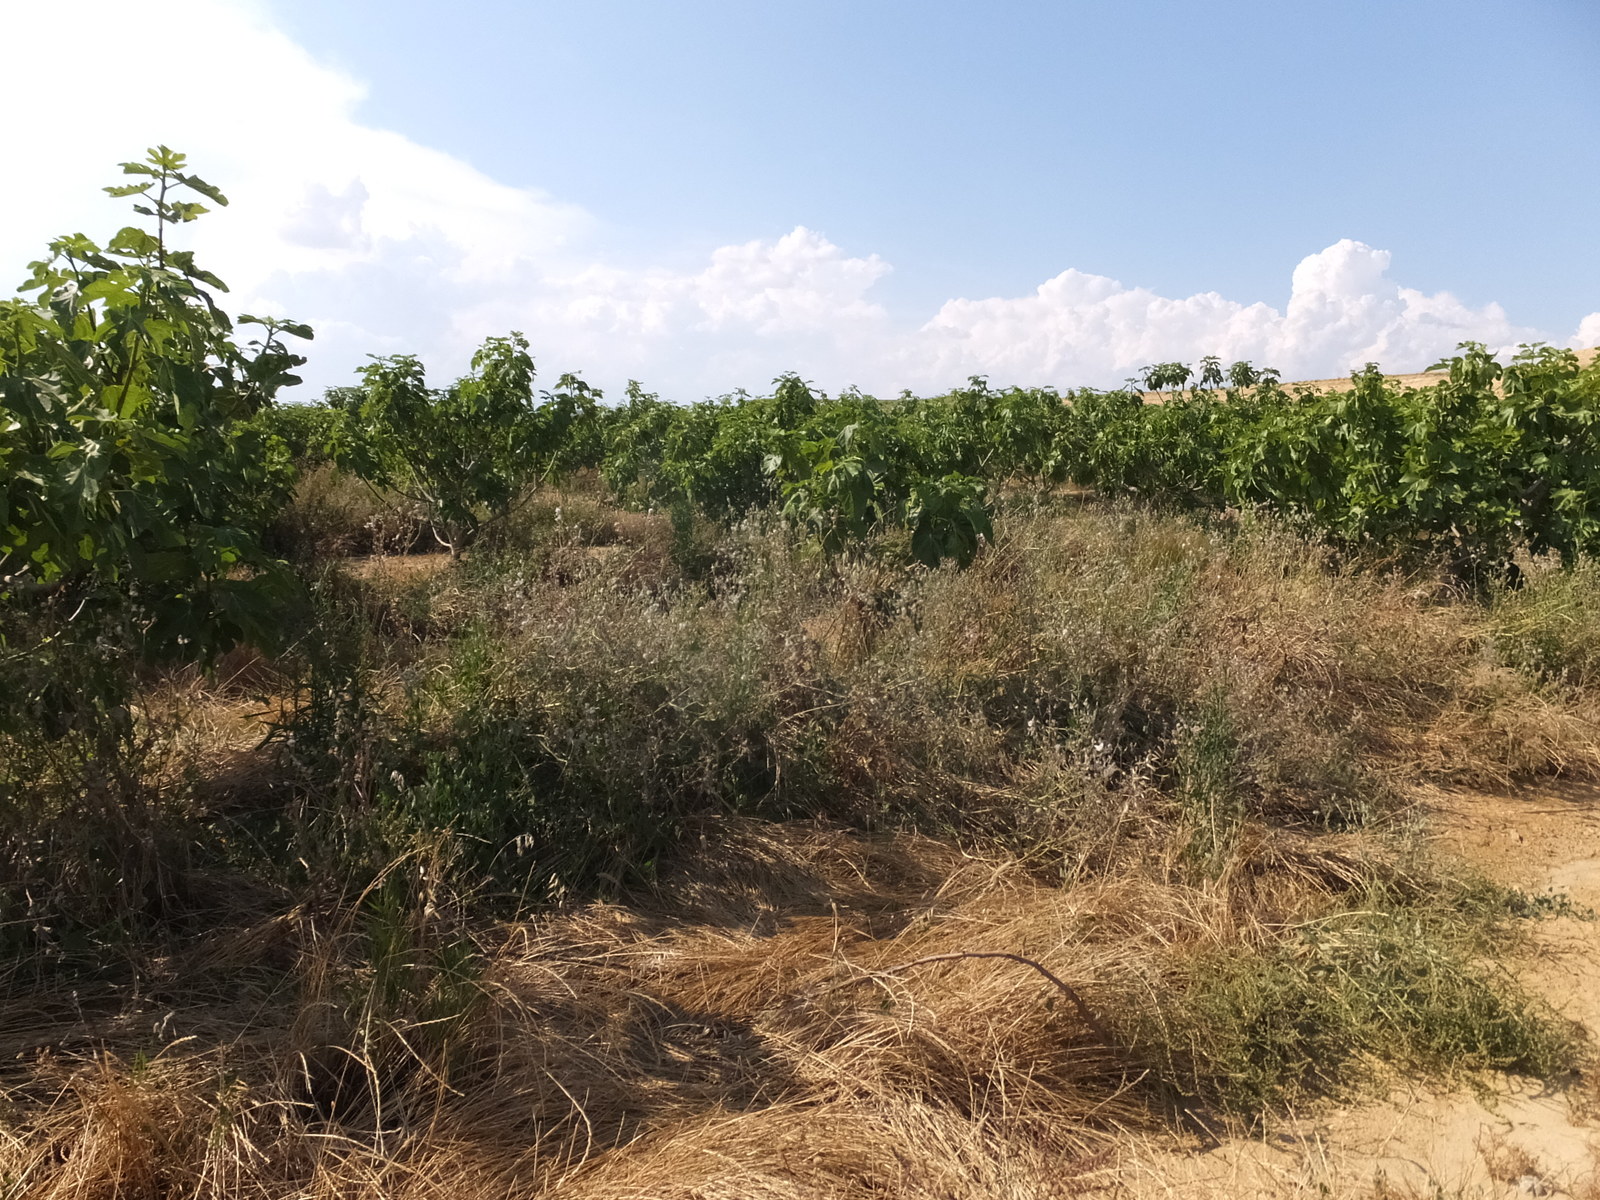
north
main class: Cropland
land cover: Other fruit trees and berries
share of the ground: > 75 %
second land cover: Spontaneously vegetated surfaces
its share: 10 - 25 %
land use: Agriculture (excluding fallow land and kitchen gardens)
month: June
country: ES
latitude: 41.7996
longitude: 0.0543
